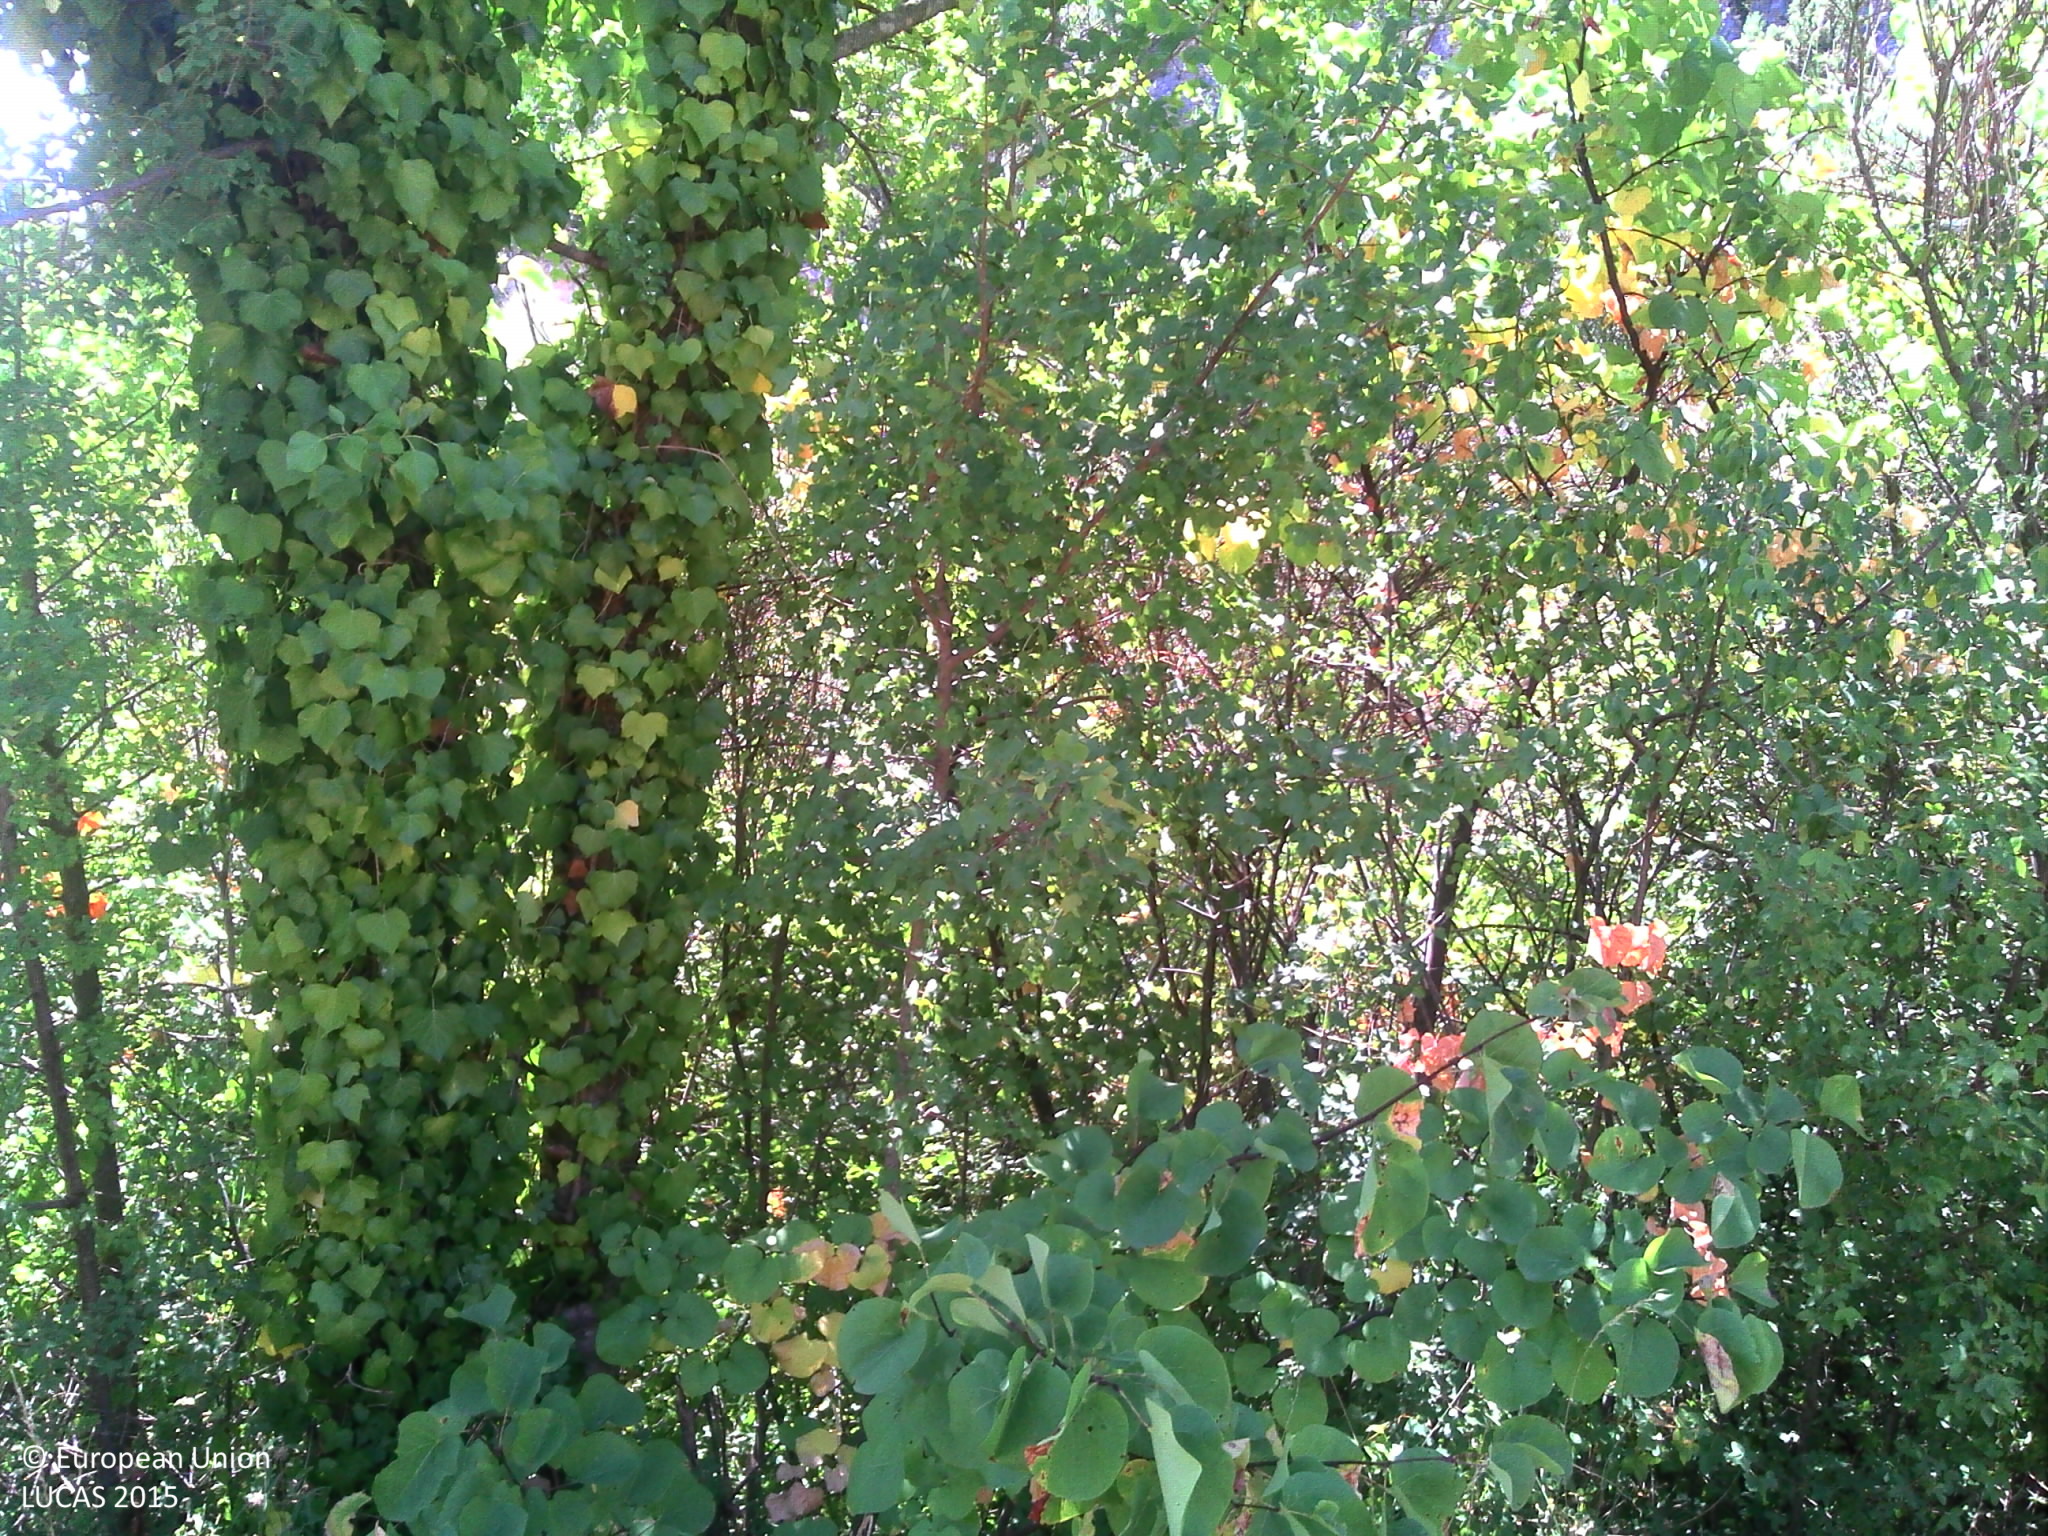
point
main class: Woodland
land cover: Other mixed woodland
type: broadleaved evergreen forest
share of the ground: > 75 %
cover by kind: broadleaved forest trees 50 %, coniferous forest trees 25 %, herbaceous plants 25 %
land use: Semi-natural and natural areas not in use
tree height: > 5 m
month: July
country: FR
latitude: 44.5755
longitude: 4.6797
